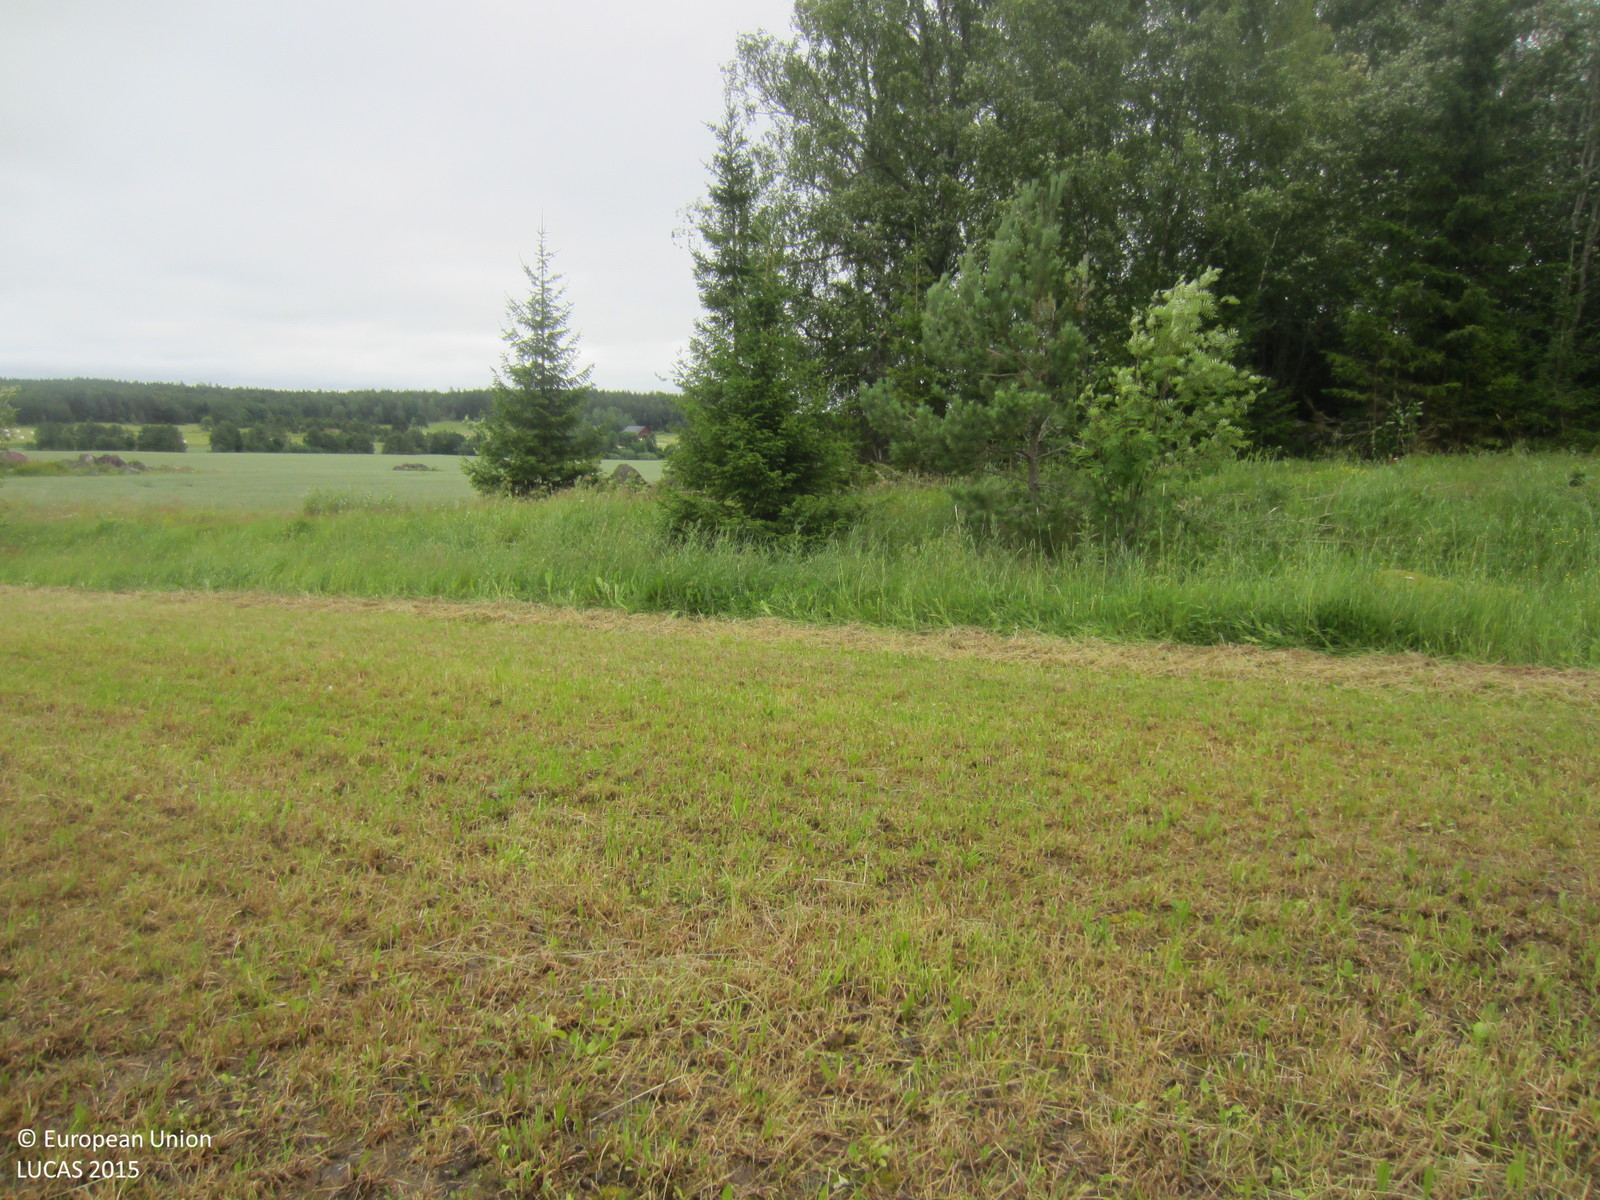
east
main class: Cropland
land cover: Other leguminous and mixtures for fodder
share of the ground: 25 - 50 %
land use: Agriculture (excluding fallow land and kitchen gardens)
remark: Harvested field
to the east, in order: Other leguminous and mixtures for fodder; Ditches and canals; Paved roads, cycling and walking lanes; Single bushes/trees; Ditches and canals; Common wheat
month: July
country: SE
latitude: 59.8080
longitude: 16.9985
